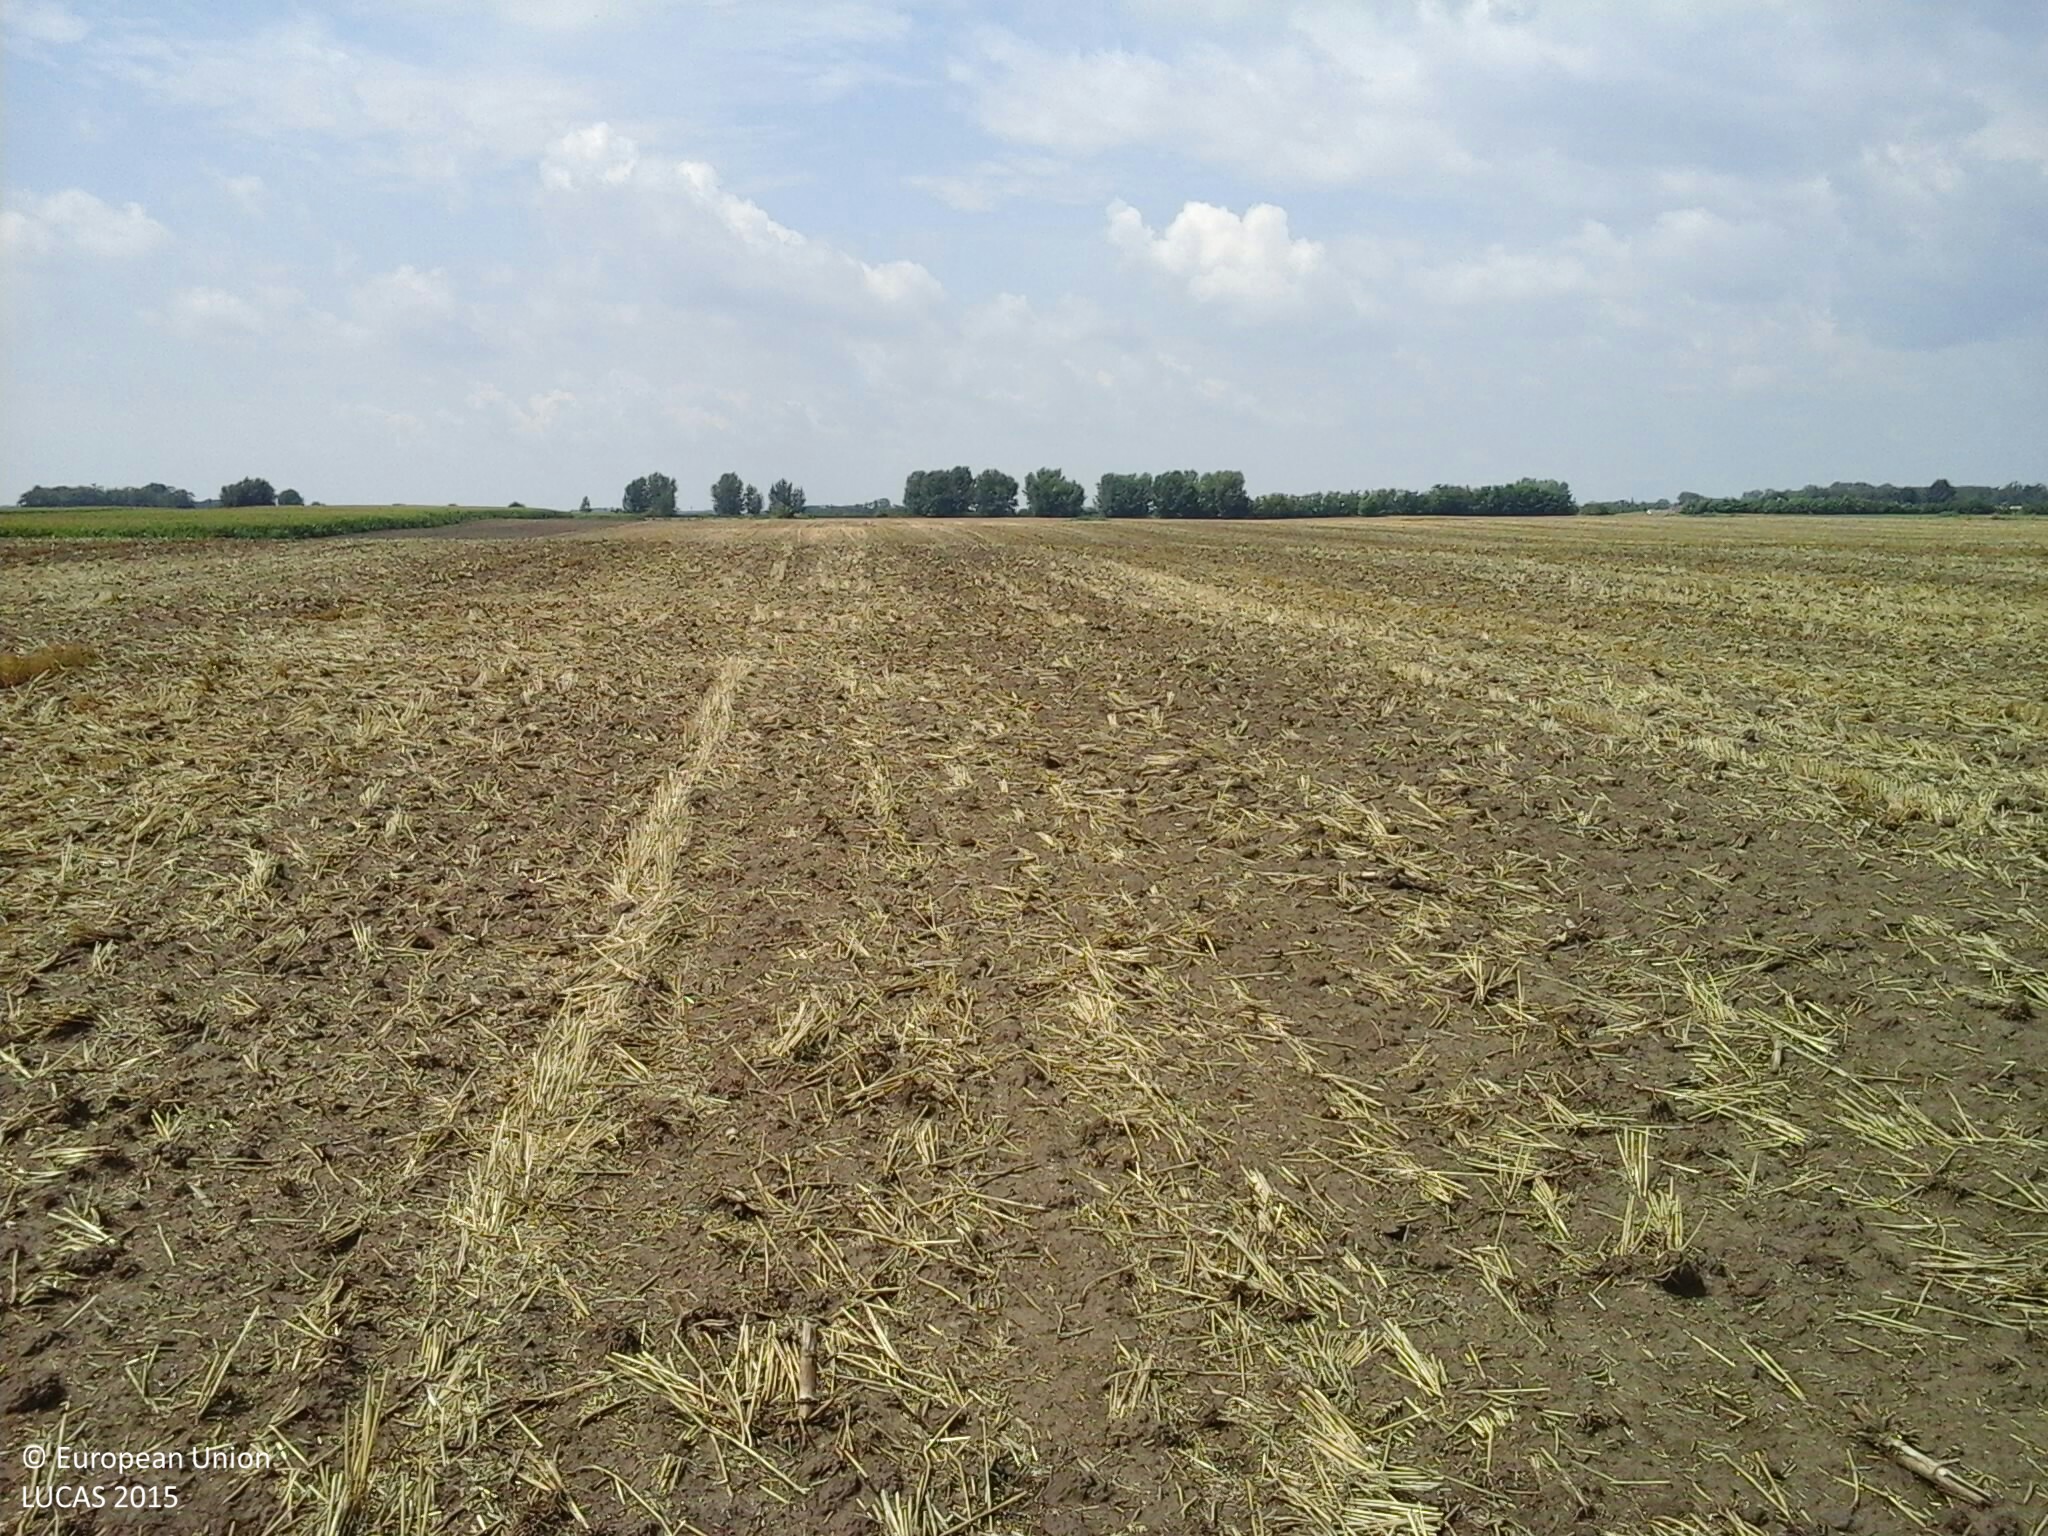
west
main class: Cropland
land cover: Common wheat
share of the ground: 10 - 25 %
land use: Agriculture (excluding fallow land and kitchen gardens)
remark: Harvested field
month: July
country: HU
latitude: 47.8997
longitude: 21.4274
